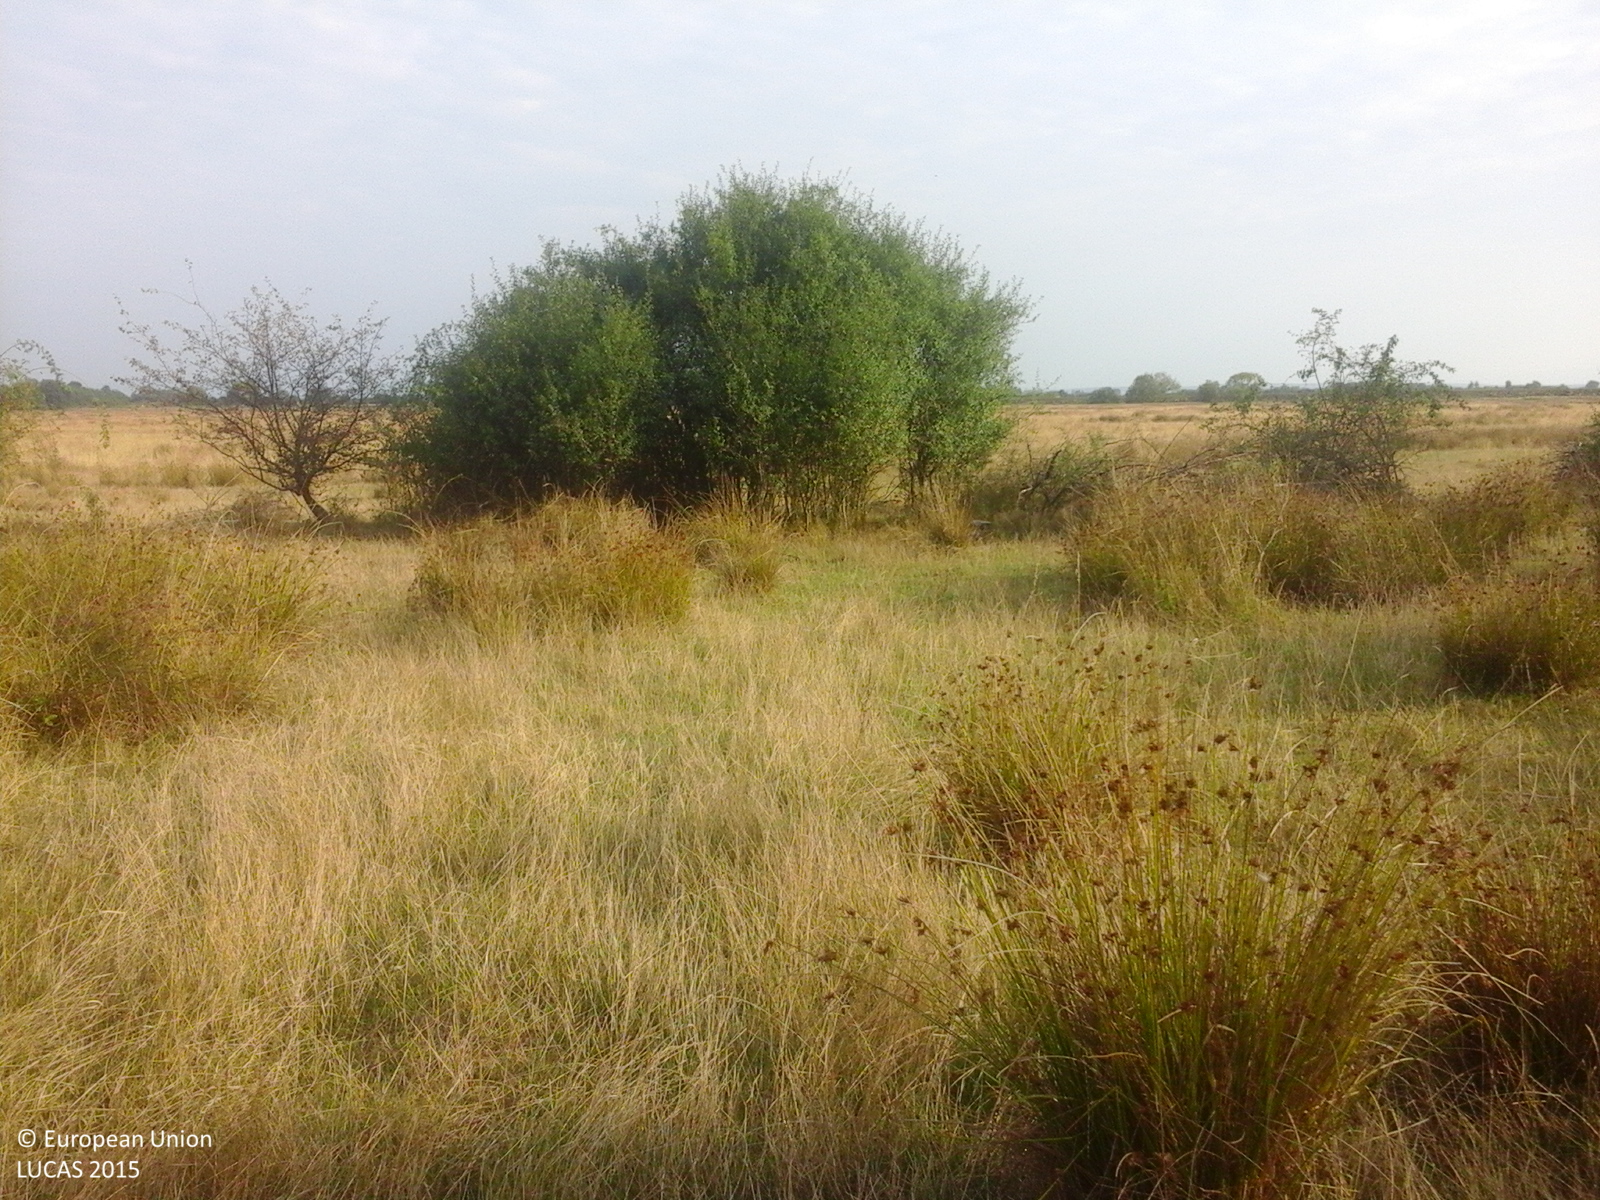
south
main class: Grassland
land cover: Grassland with sparse tree/shrub cover
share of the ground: > 75 %
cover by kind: herbaceous plants 85 %, shrubs 10 %, broadleaved forest trees 5 %
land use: Agriculture (excluding fallow land and kitchen gardens)
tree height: < 5 m
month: August
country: RO
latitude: 46.4958
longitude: 21.9656
